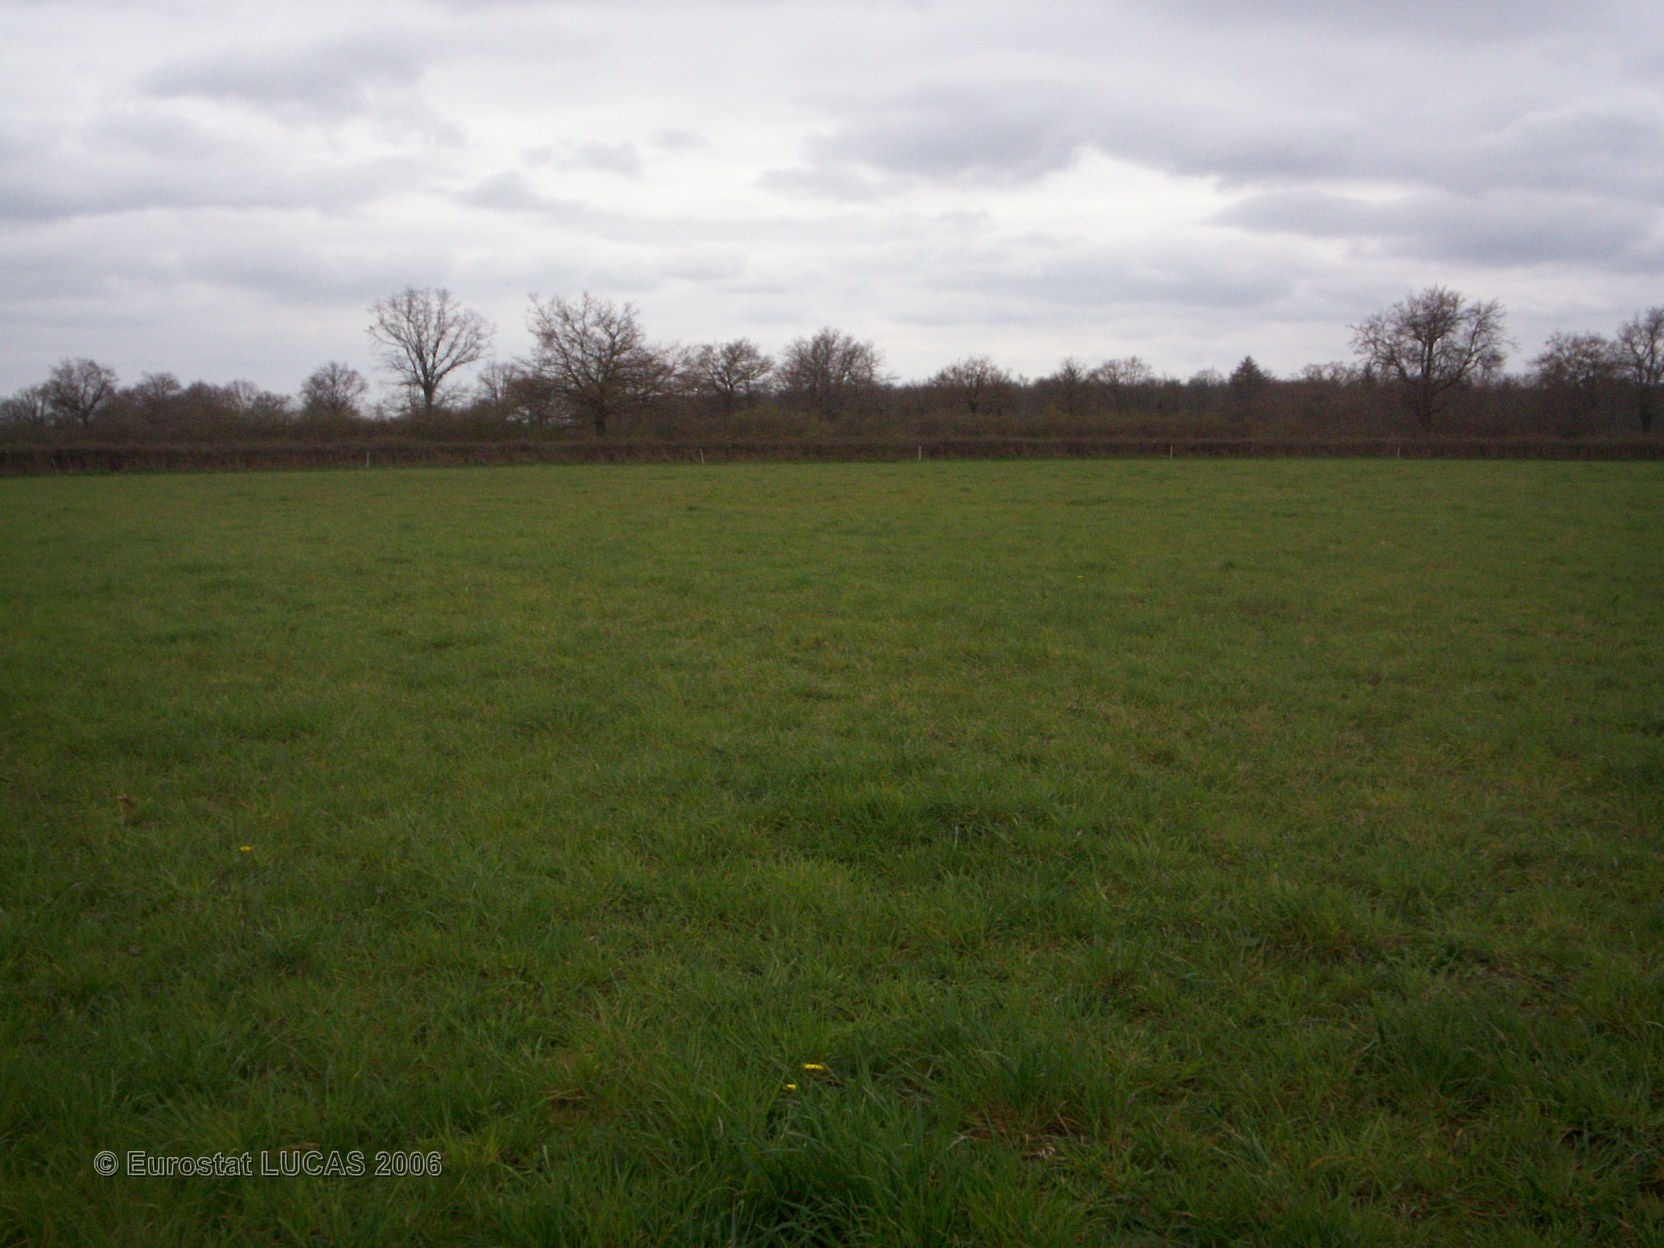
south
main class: Grassland
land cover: Grassland without tree/shrub cover
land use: Agriculture (excluding fallow land and kitchen gardens)
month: April
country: FR
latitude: 46.6984
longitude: 2.9736
